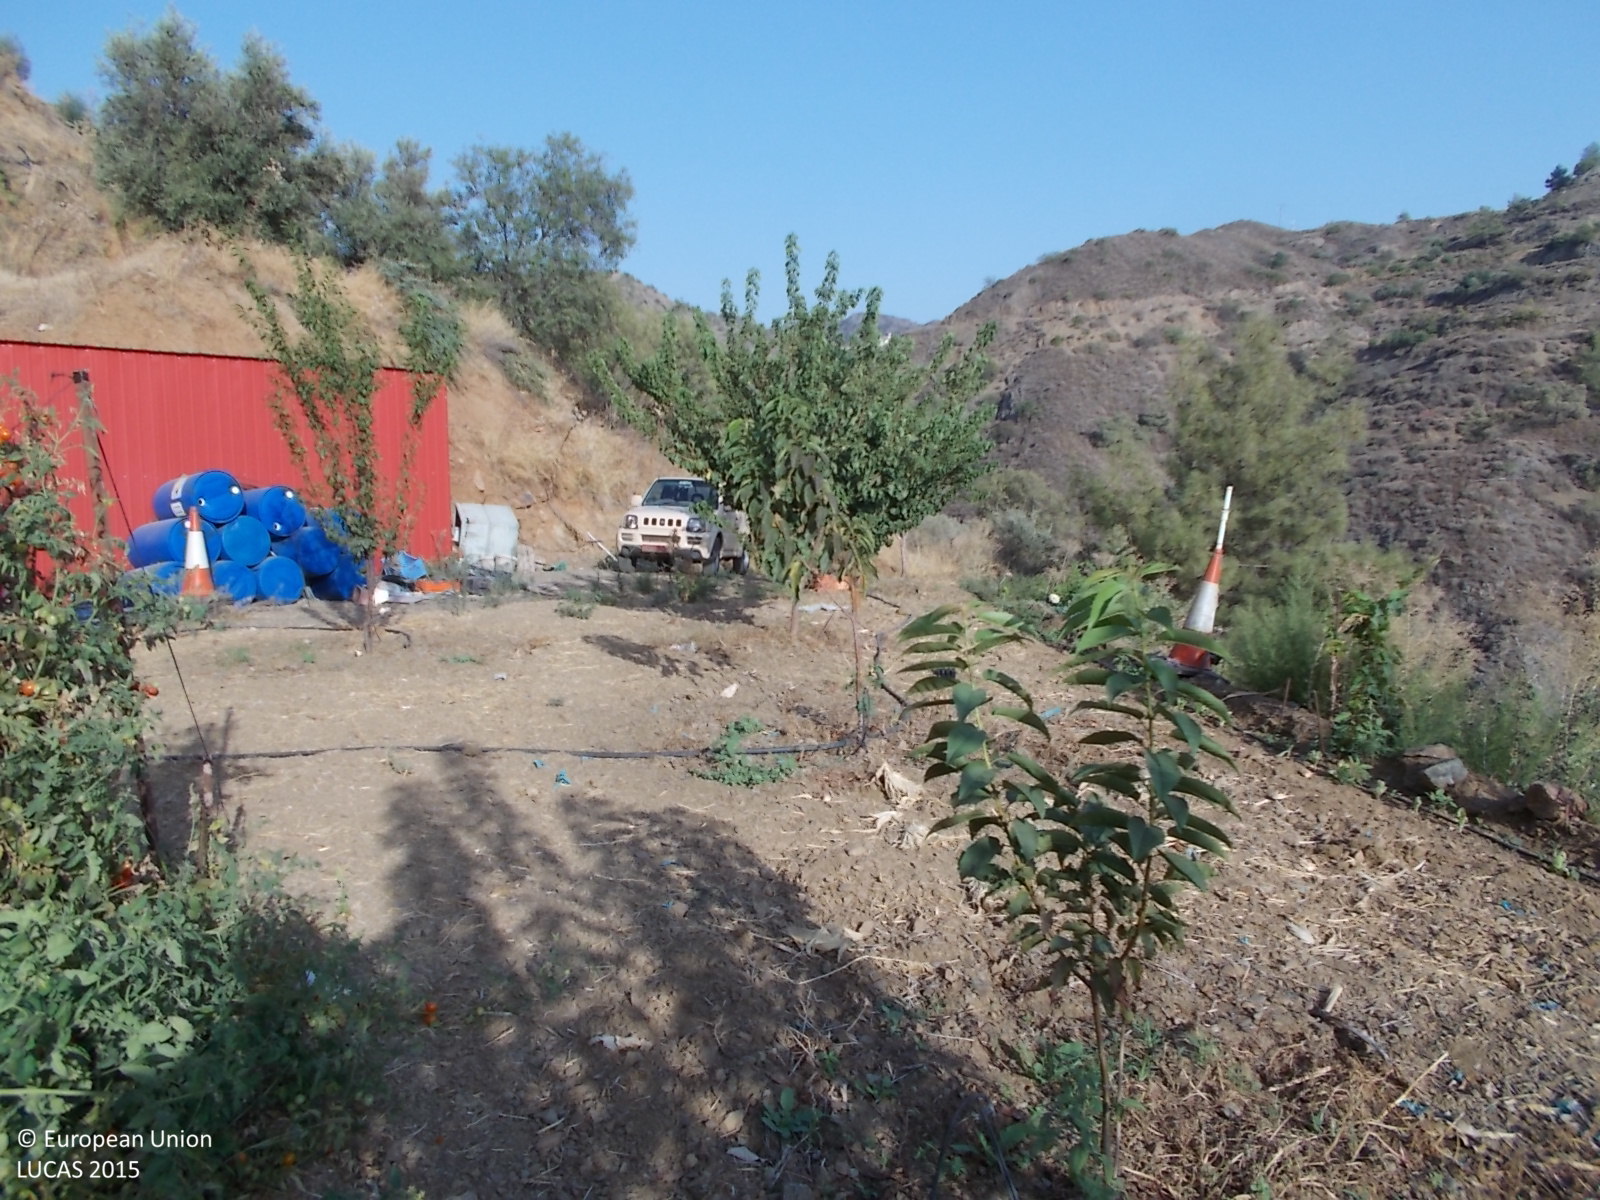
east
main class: Cropland
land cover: Tomatoes
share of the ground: 10 - 25 %
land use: Agriculture (excluding fallow land and kitchen gardens)
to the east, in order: Tomatoes; Other fruit trees and berries; Other bare soil; Tracks; Shrubland with sparse tree cover; Olive groves; Paved roads, cycling and walking lanes; Fences; Olive groves; Artificial constructions in urban areas; Grassland with sparse tree/shrub cover; Olive groves; Nuts trees
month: April
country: CY
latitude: 34.8778
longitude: 33.1849
